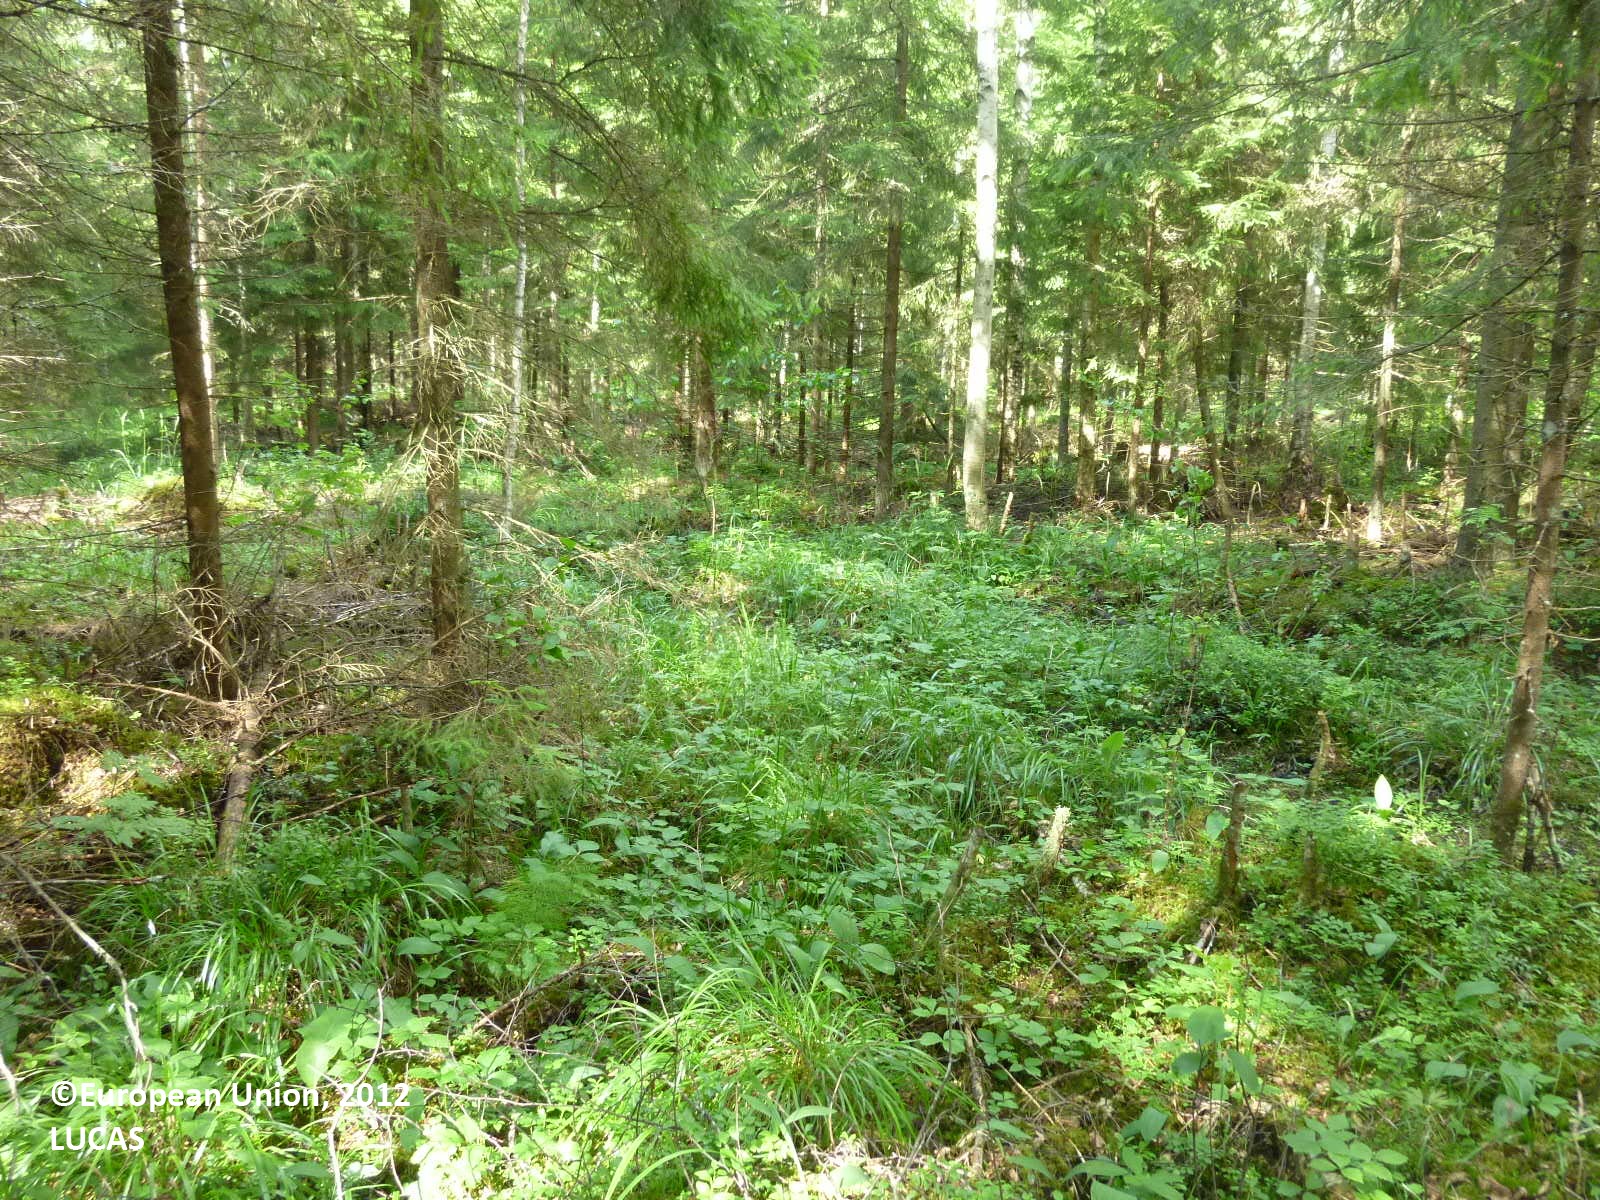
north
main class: Woodland
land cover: Spruce dominated mixed woodland
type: boreal forest
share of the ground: > 75 %
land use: Forestry
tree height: > 5 m
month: July
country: FI
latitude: 61.2563
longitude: 21.9696
